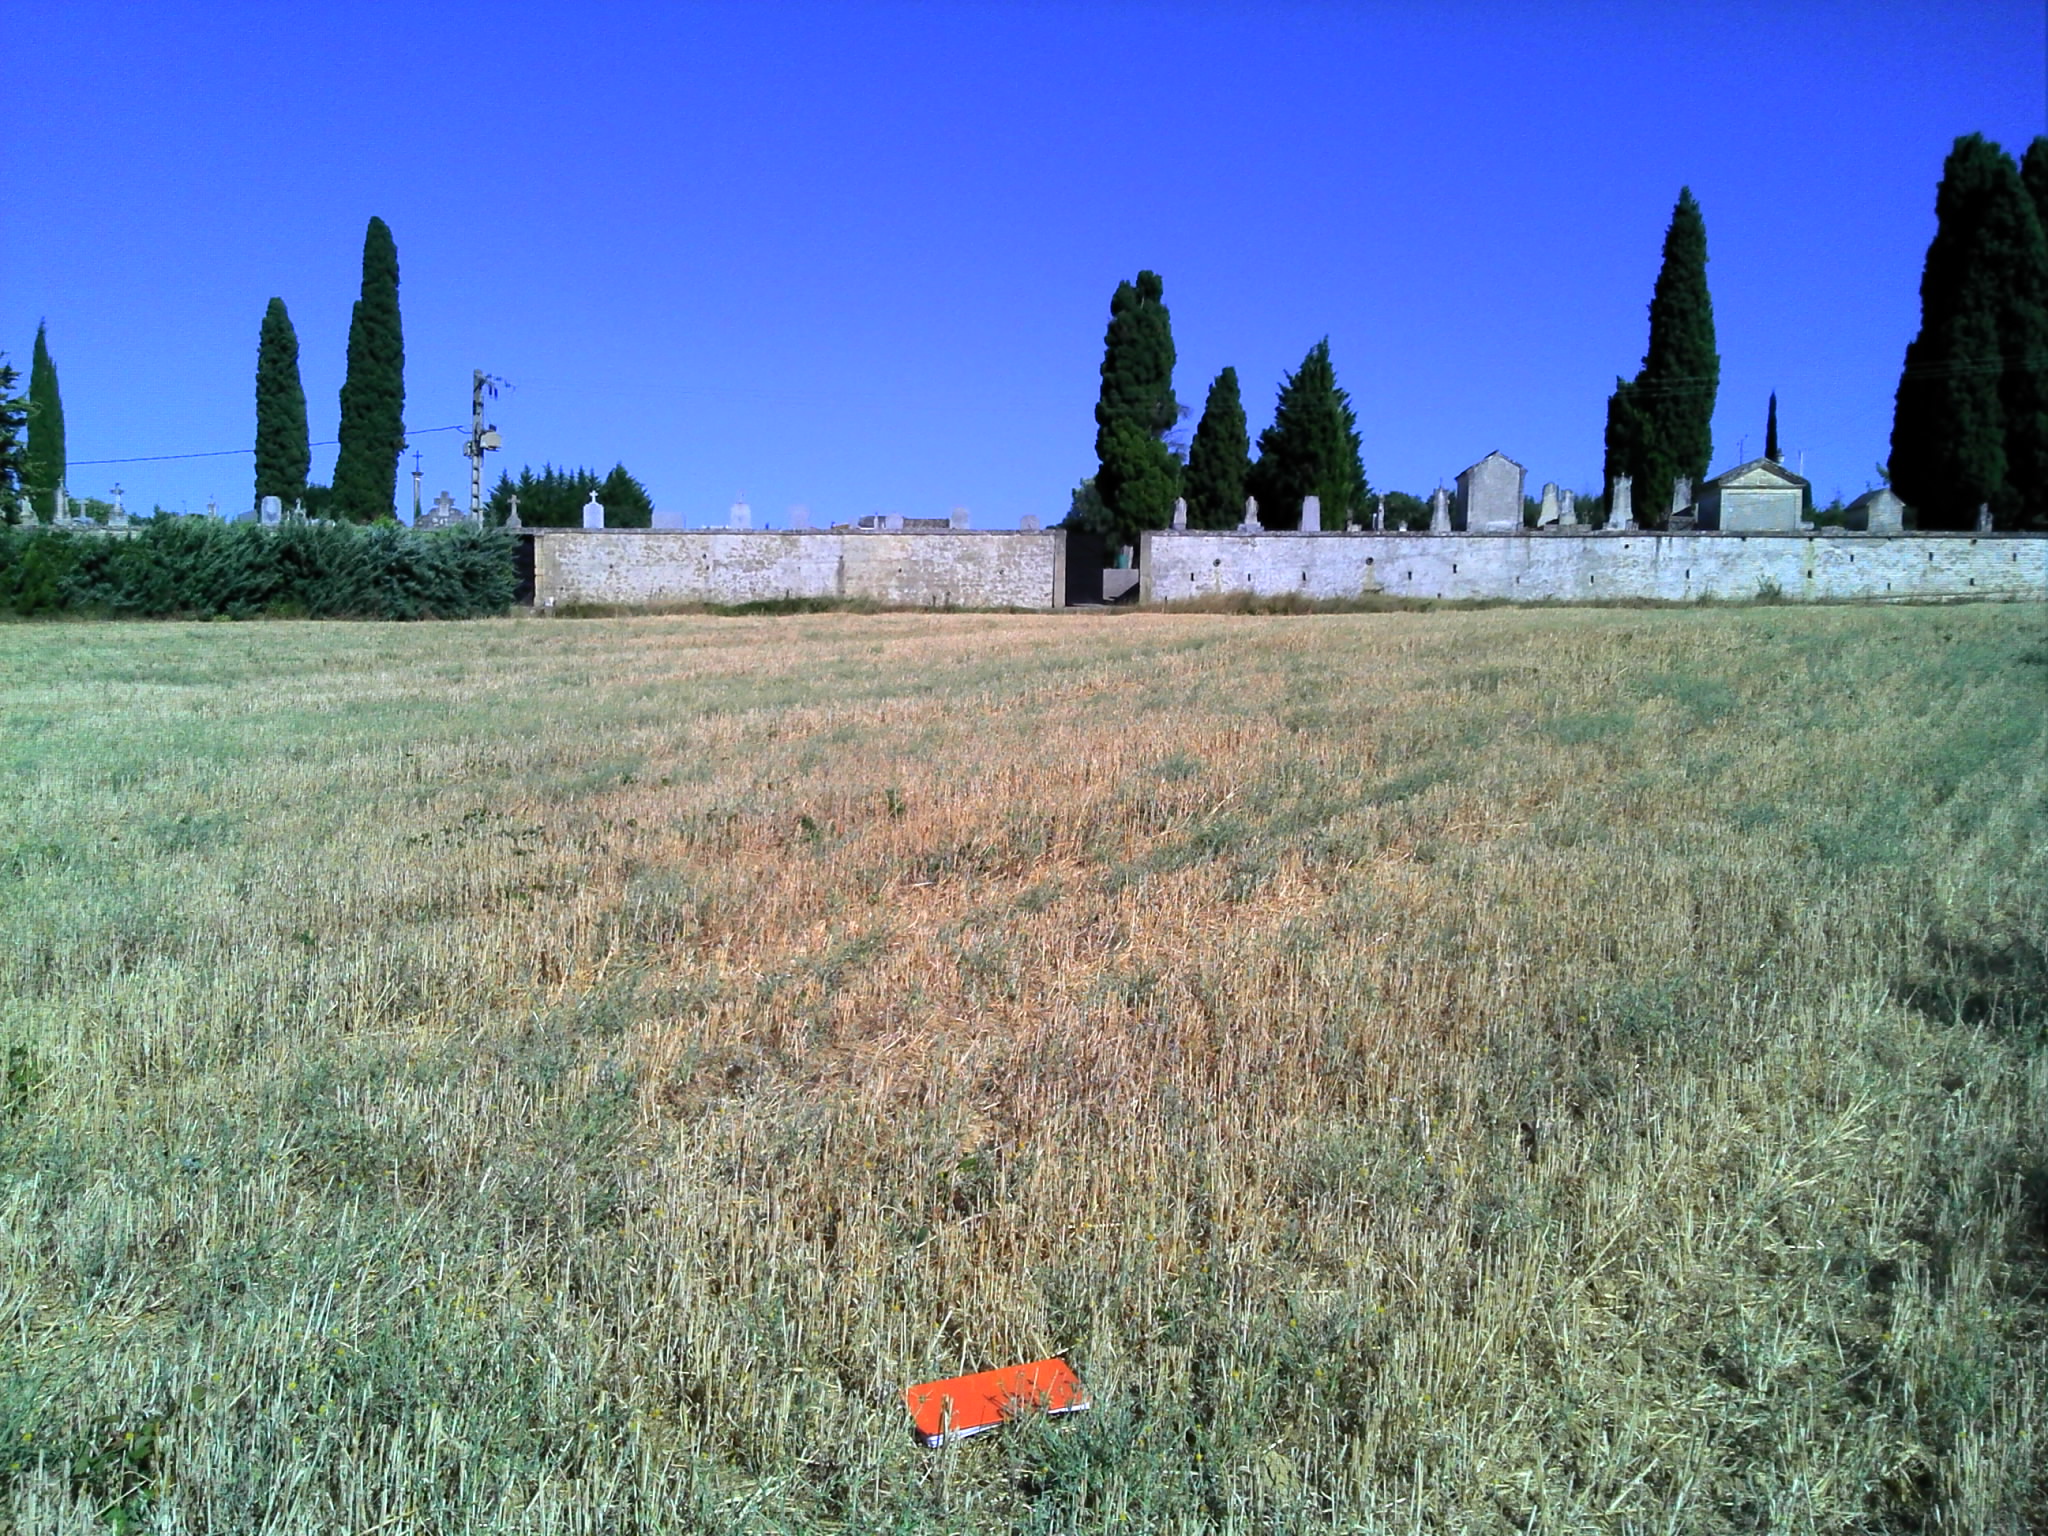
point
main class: Cropland
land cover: Barley
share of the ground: 10 - 25 %
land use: Agriculture (excluding fallow land and kitchen gardens)
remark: Harvested field
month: July
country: FR
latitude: 43.9623
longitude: 4.3626
